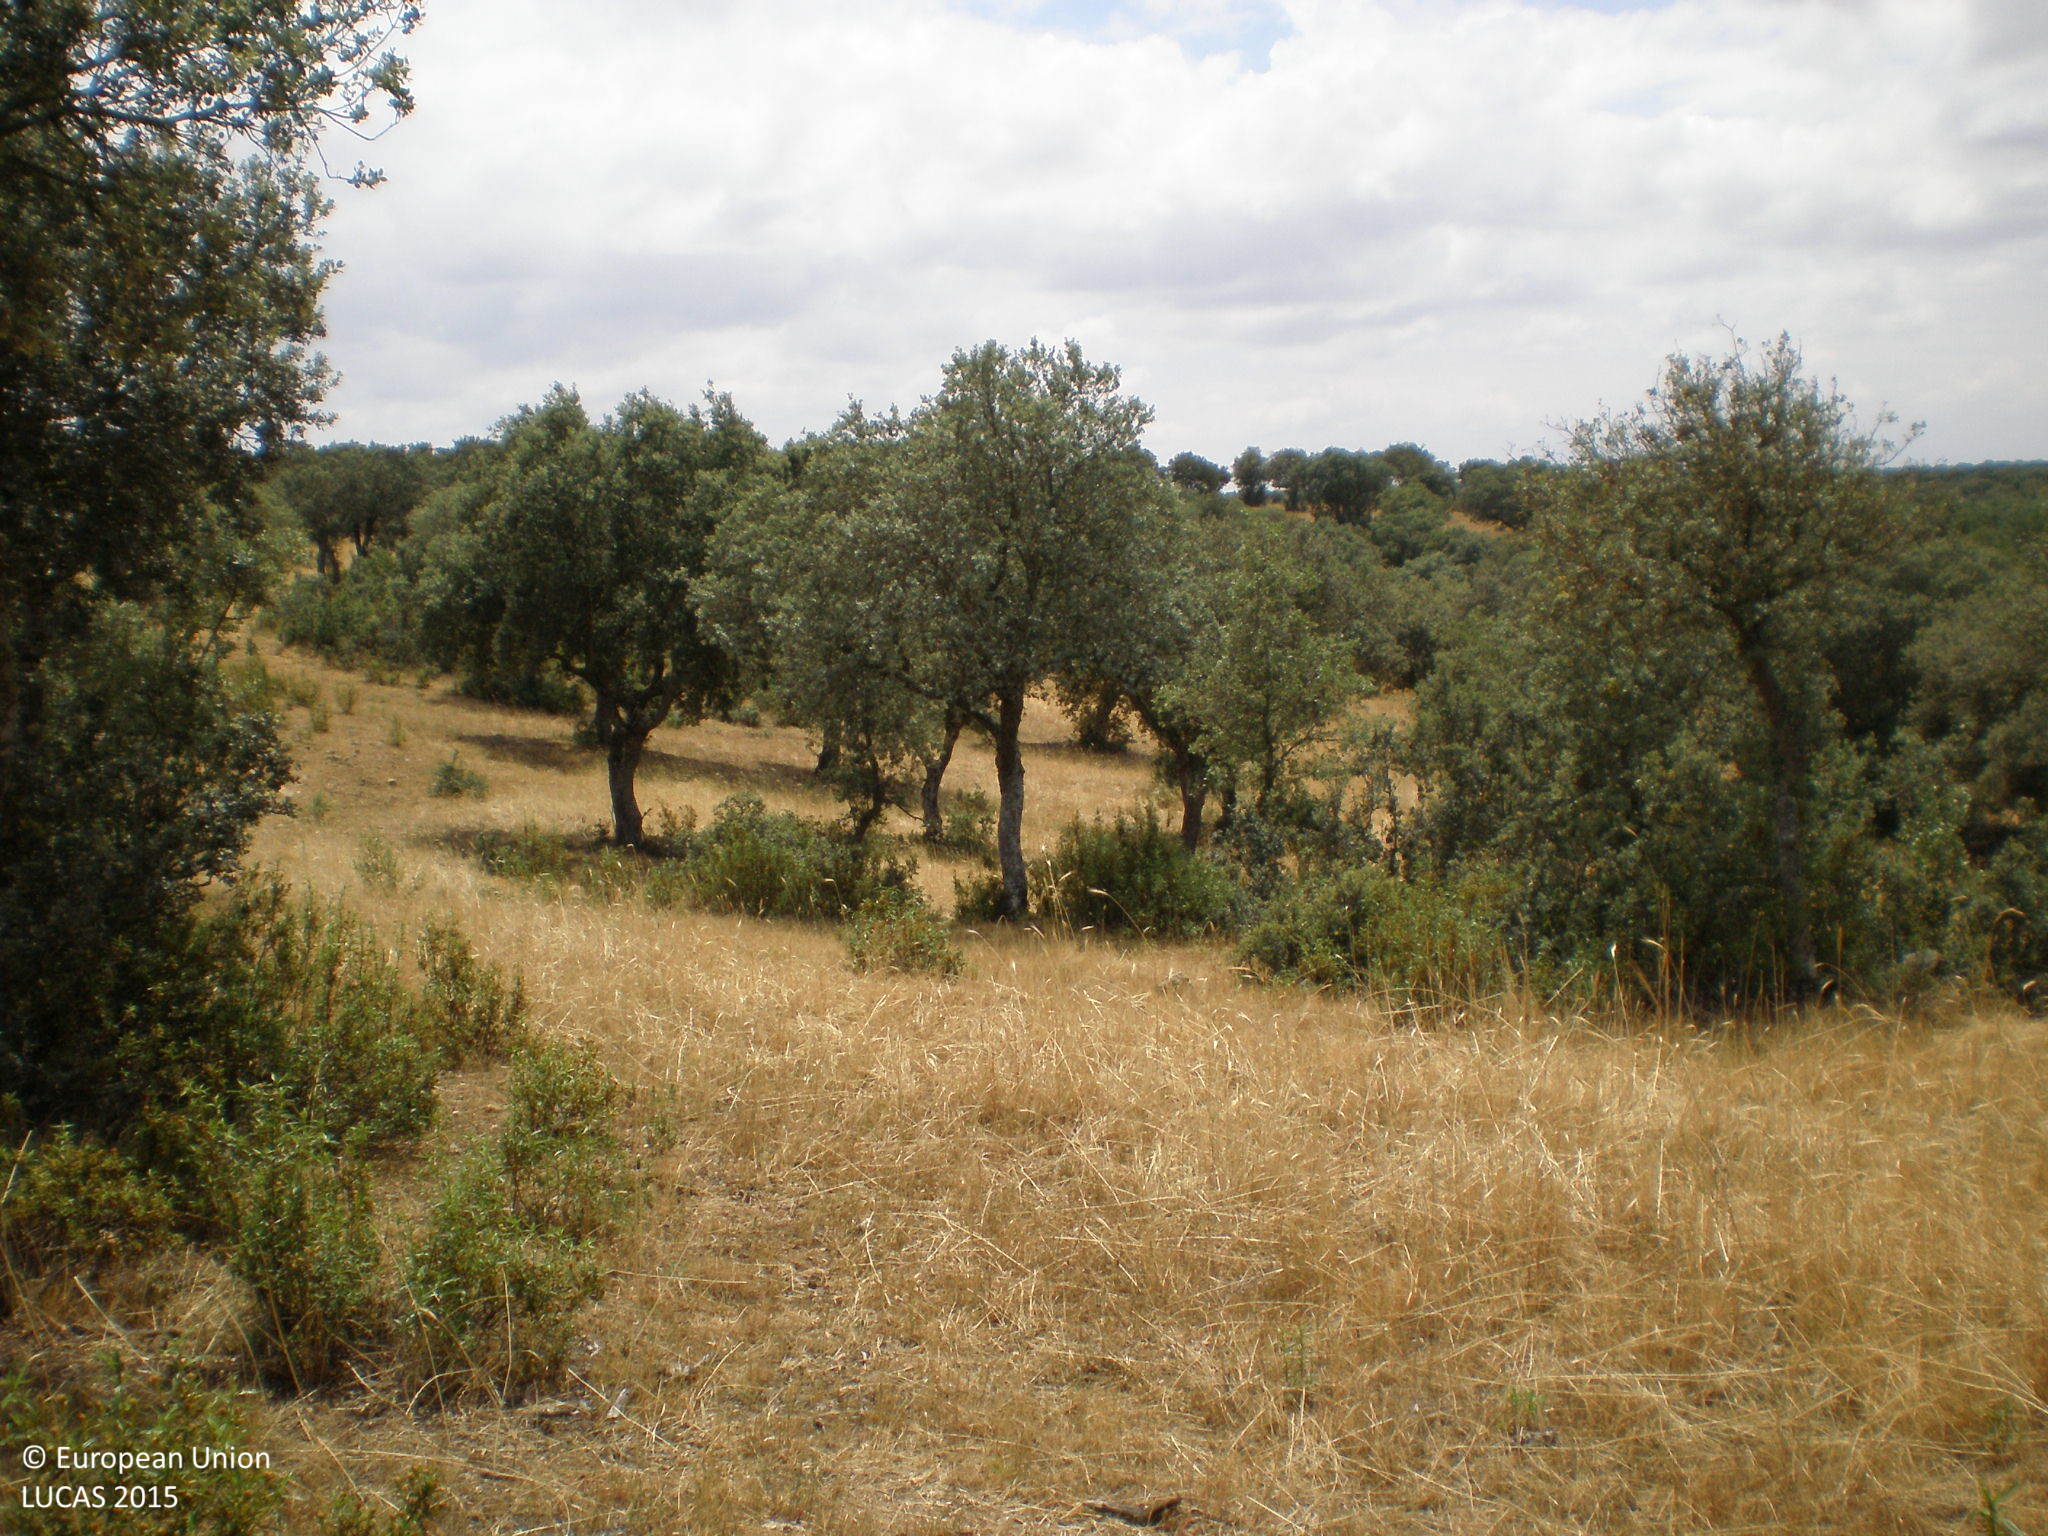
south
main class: Woodland
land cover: Broadleaved woodland
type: broadleaved evergreen forest
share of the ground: 25 - 50 %
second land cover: Rye
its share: 50 - 75 %
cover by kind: herbaceous plants 70 %, broadleaved forest trees 30 %
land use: Forestry
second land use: Agriculture (excluding fallow land and kitchen gardens)
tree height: < 5 m
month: June
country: ES
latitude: 41.1376
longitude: -5.7474
